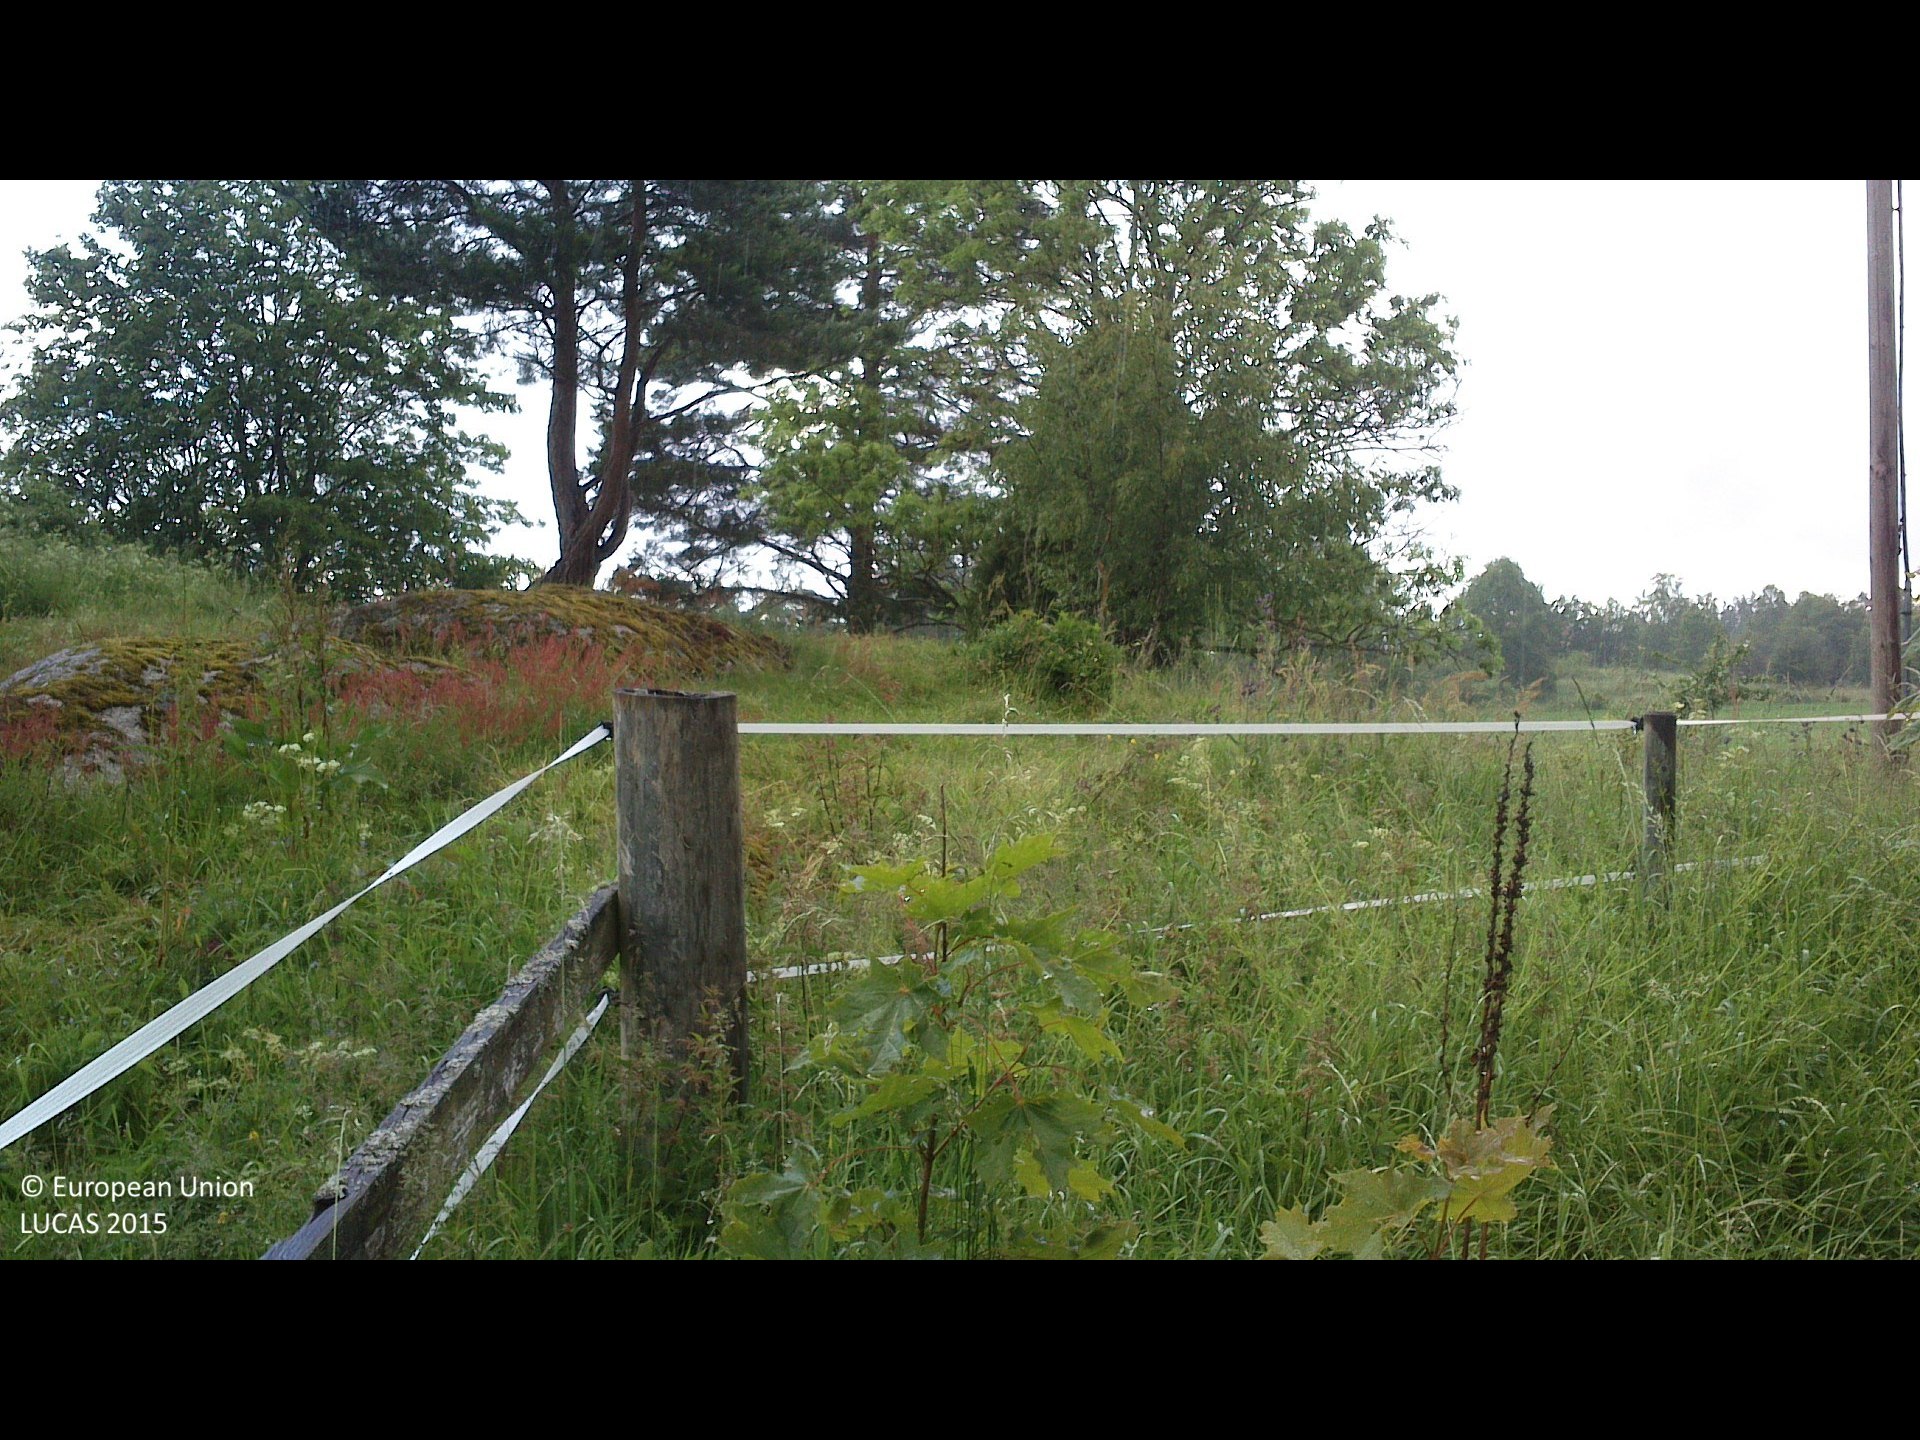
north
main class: Grassland
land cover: Grassland without tree/shrub cover
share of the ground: > 75 %
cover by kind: herbaceous plants 100 %
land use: Agriculture (excluding fallow land and kitchen gardens)
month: June
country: SE
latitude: 58.1160
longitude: 15.7159
